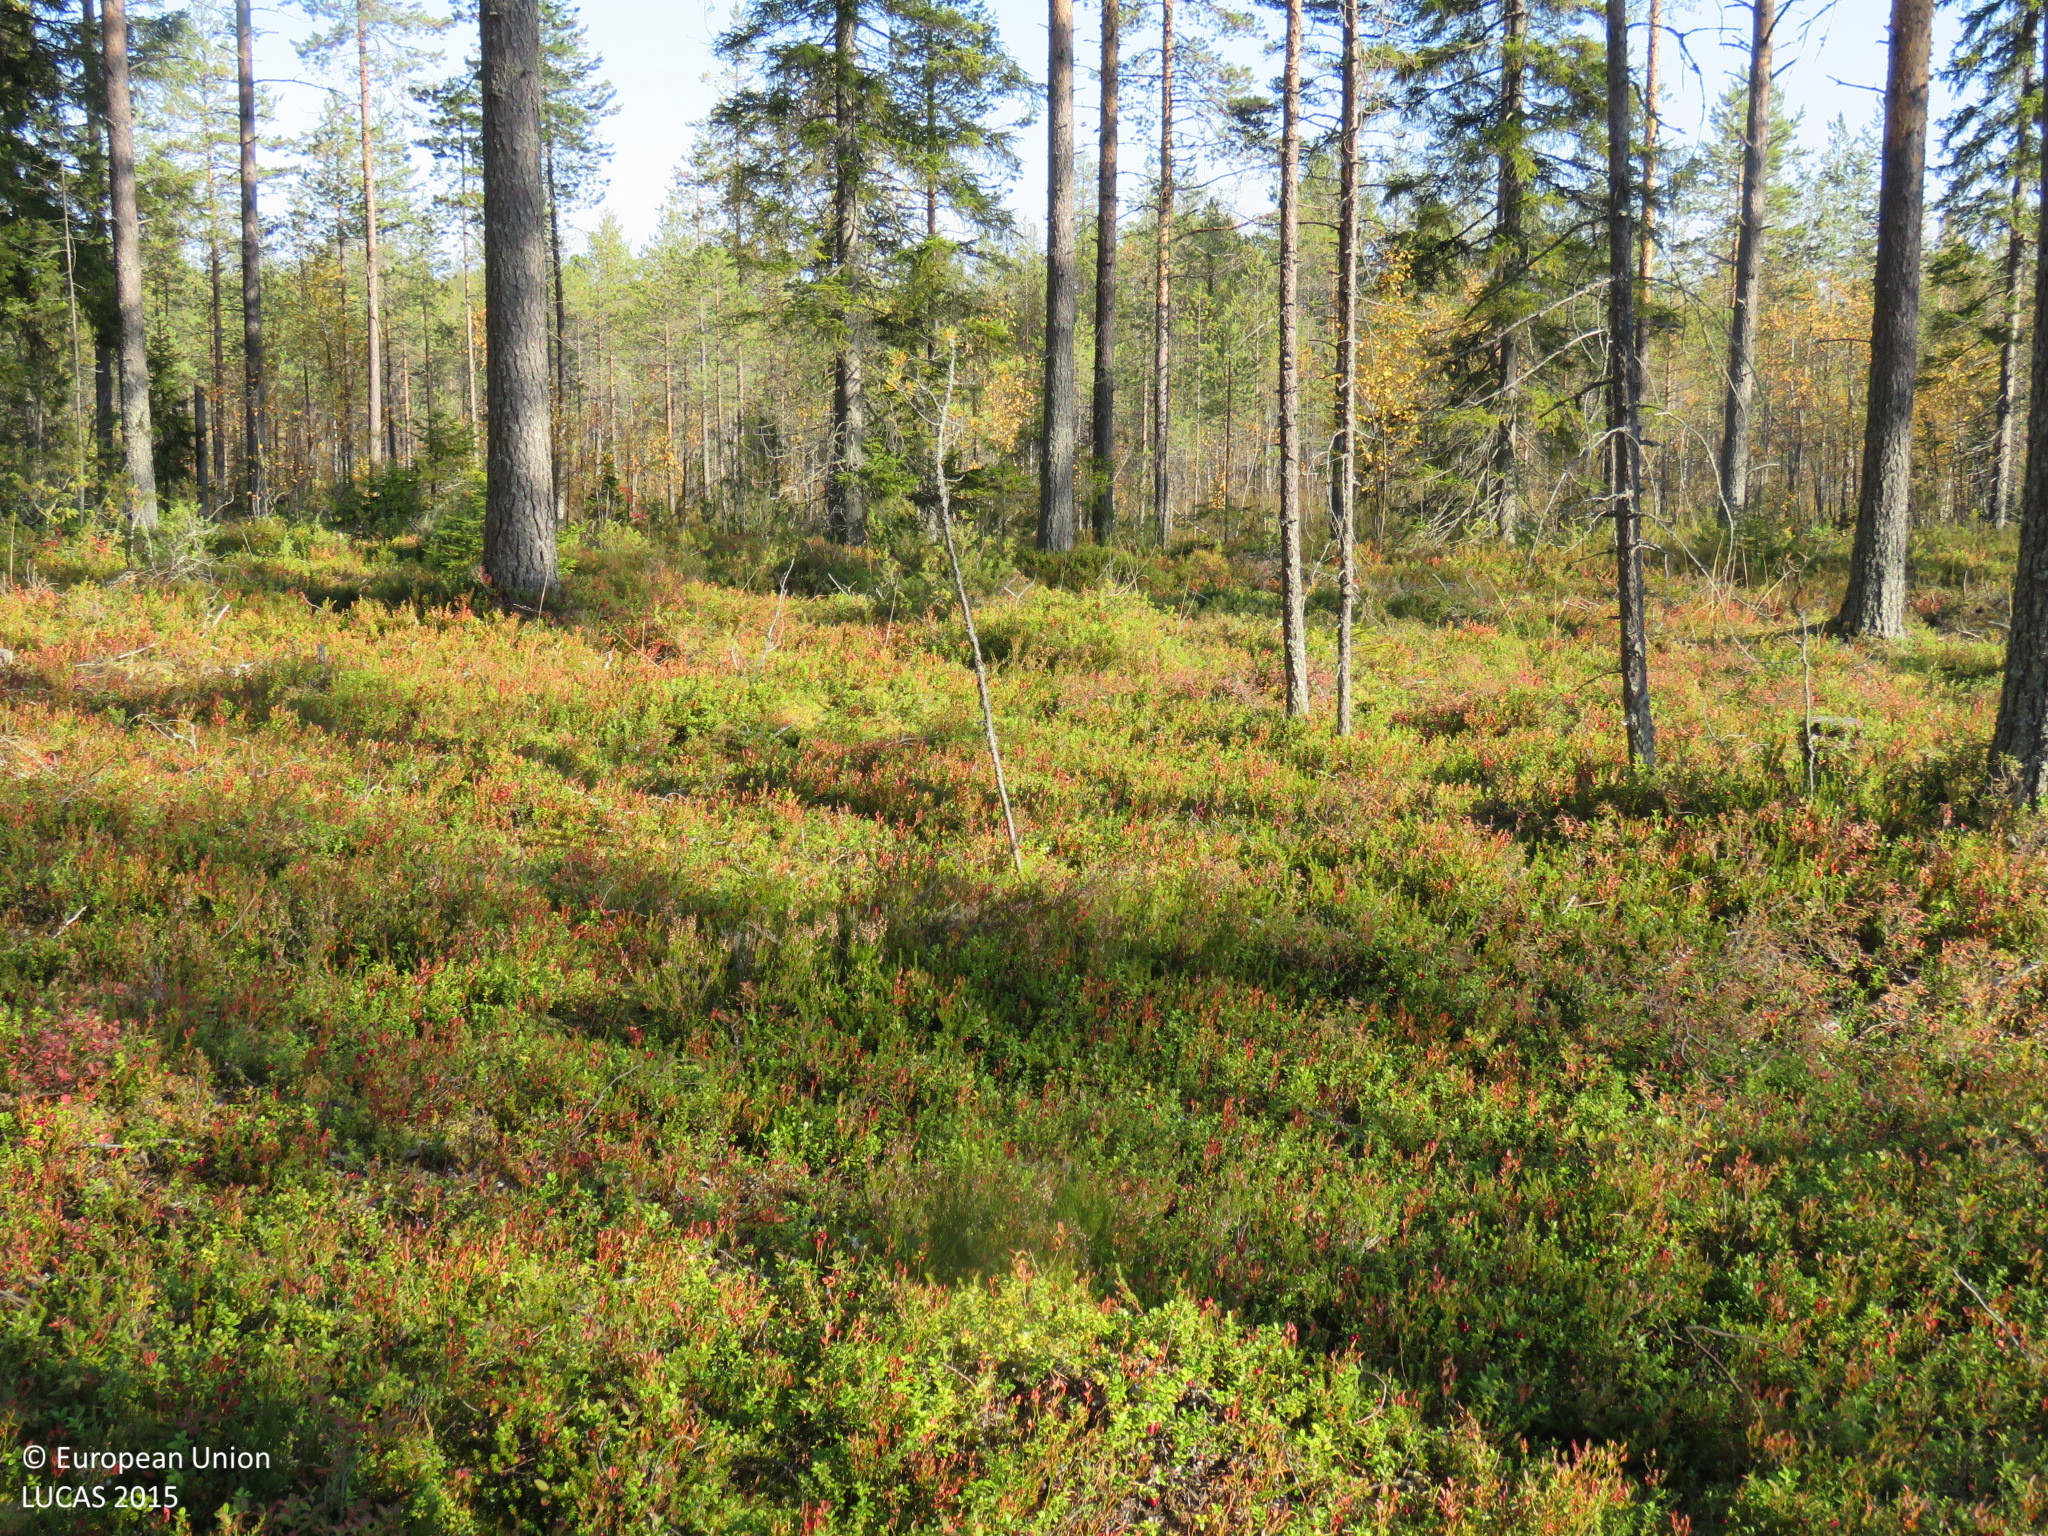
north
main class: Woodland
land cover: Pine dominated coniferous woodland
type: boreal forest
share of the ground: 50 - 75 %
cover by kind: coniferous forest trees 60 %, shrubs 30 %, lichens and mosses 10 %
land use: Forestry
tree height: > 5 m
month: September
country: FI
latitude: 64.9789
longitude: 26.9671
